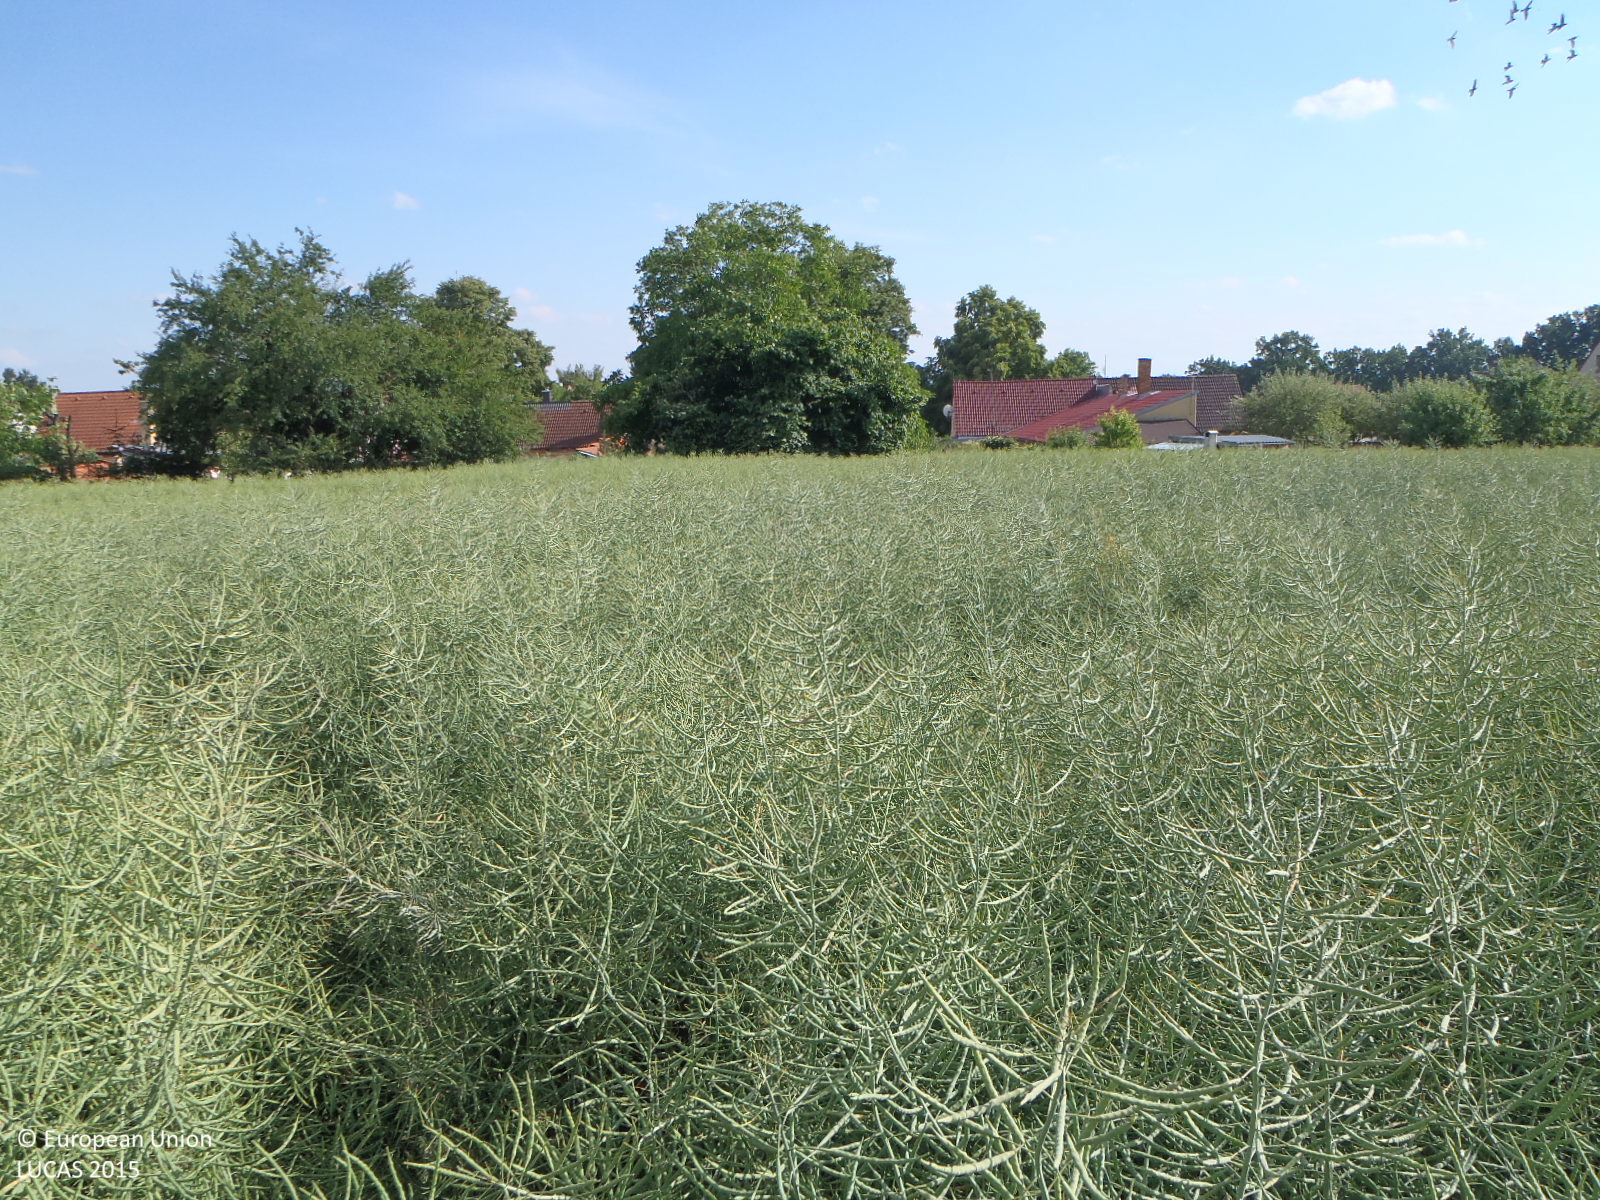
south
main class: Cropland
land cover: Rape and turnip rape
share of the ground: > 75 %
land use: Agriculture (excluding fallow land and kitchen gardens)
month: June
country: CZ
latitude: 49.0919
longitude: 14.3694
